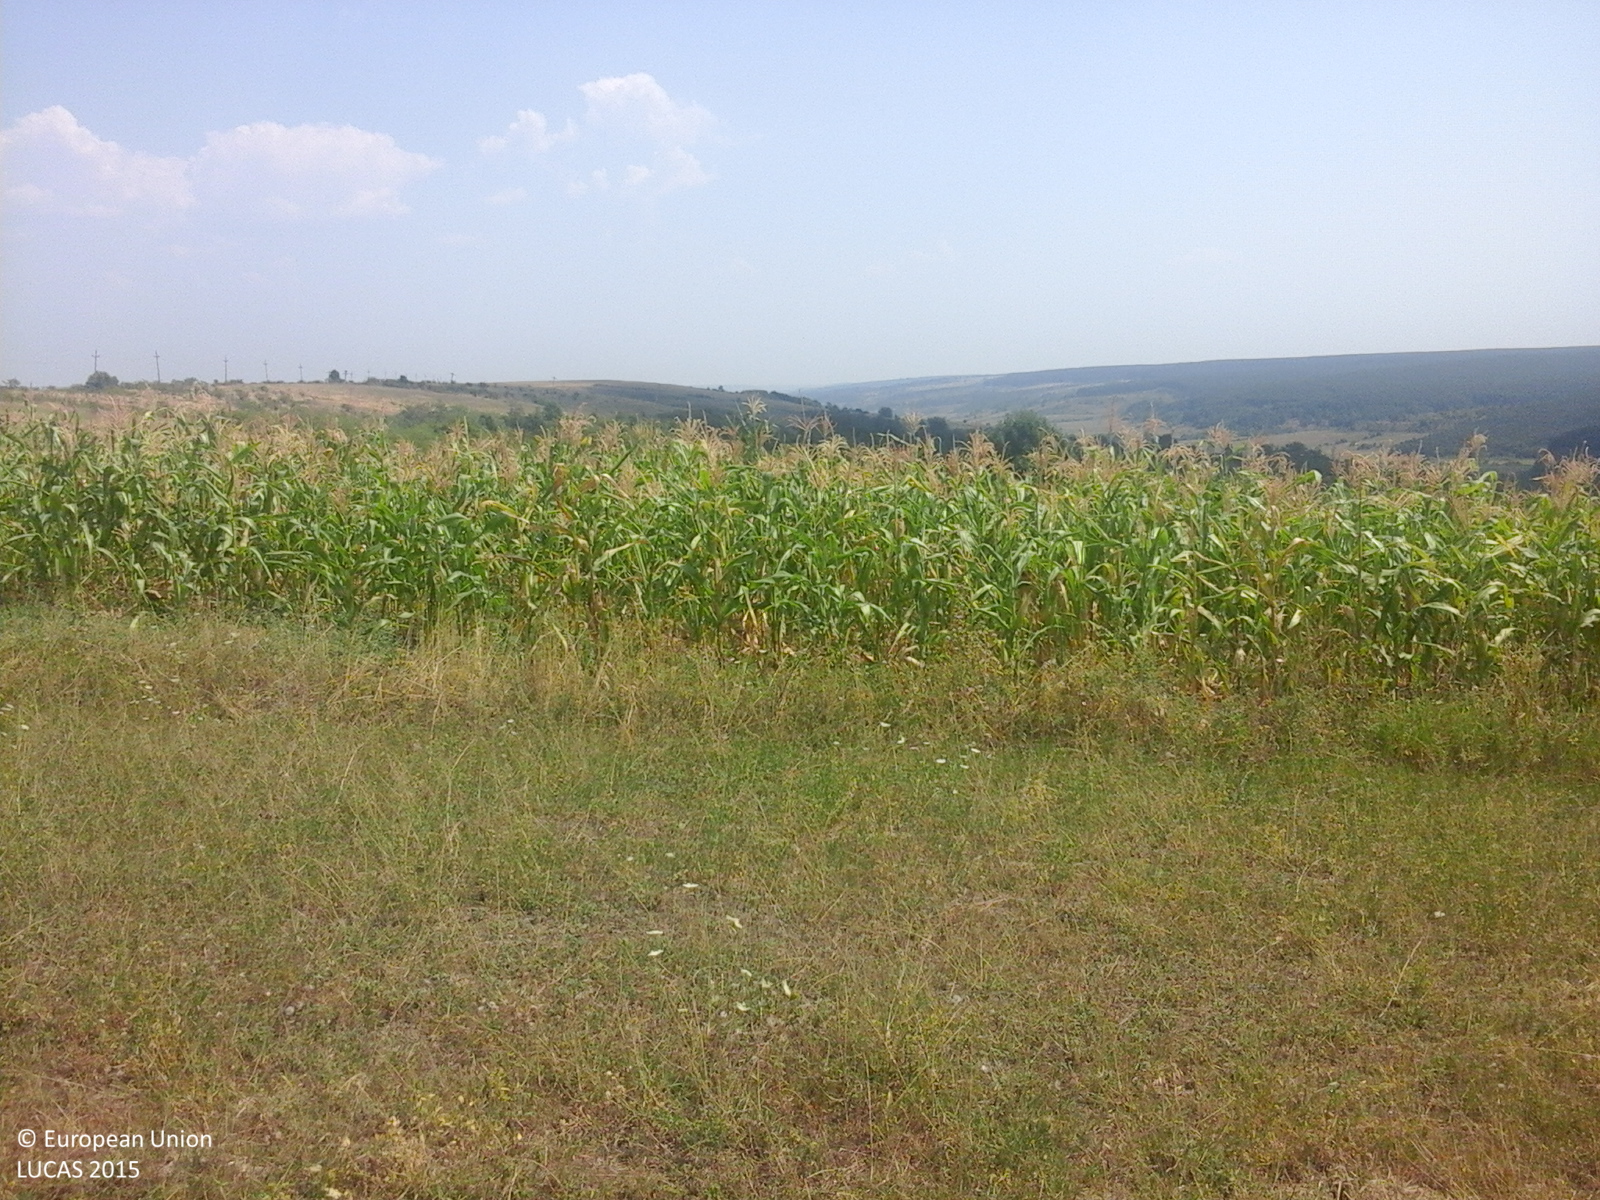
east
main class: Grassland
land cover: Grassland without tree/shrub cover
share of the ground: > 75 %
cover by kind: herbaceous plants 100 %
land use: Agriculture (excluding fallow land and kitchen gardens)
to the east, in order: Grassland without tree/shrub cover; Maize; Tracks; Oats; Grassland with sparse tree/shrub cover; Shrubland with sparse tree cover; Broadleaved woodland
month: August
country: RO
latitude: 44.5112
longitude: 23.1684
